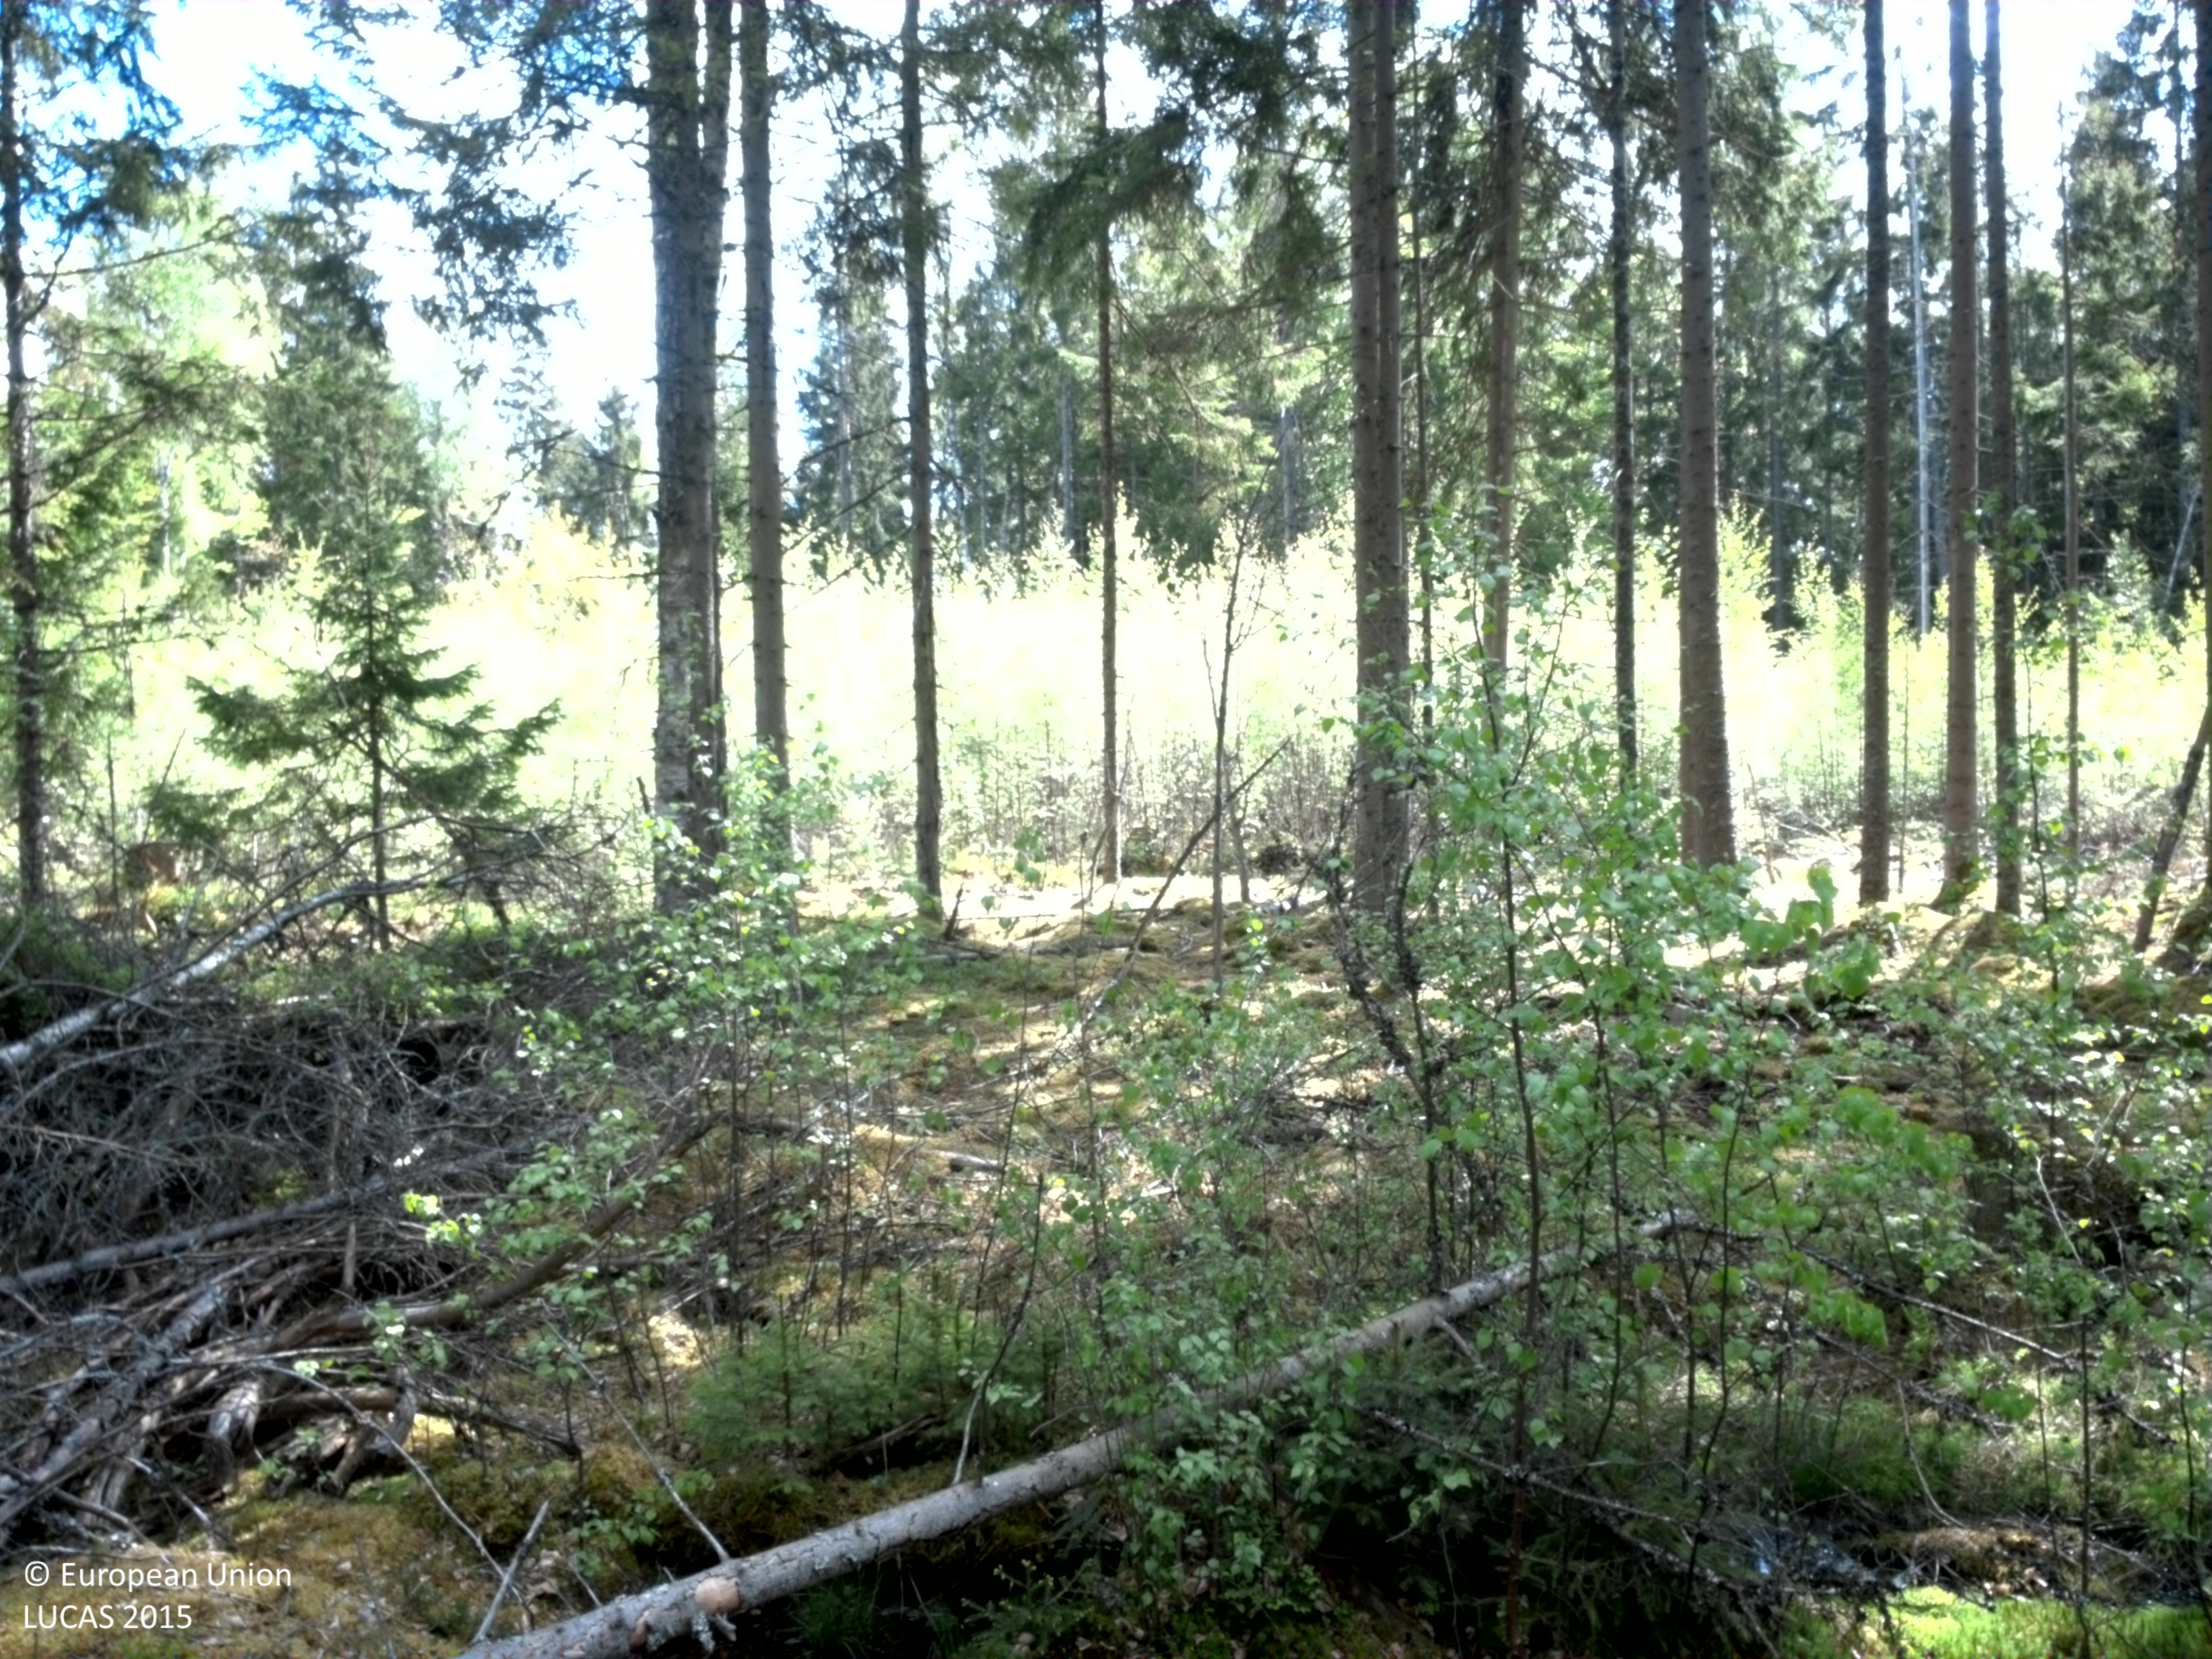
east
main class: Woodland
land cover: Pine dominated coniferous woodland
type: boreal forest
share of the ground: > 75 %
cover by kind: coniferous forest trees 60 %, broadleaved forest trees 20 %, shrubs 10 %, lichens and mosses 10 %
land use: Forestry
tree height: > 5 m
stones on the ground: < 10 %
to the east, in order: Pine dominated coniferous woodland; Ditches and canals; Broadleaved woodland; Spruce dominated coniferous woodland; Broadleaved woodland; Grassland without tree/shrub cover; Broadleaved woodland; Grassland without tree/shrub cover; Ditches and canals; Grassland without tree/shrub cover
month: May
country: SE
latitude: 56.5971
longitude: 14.4436
